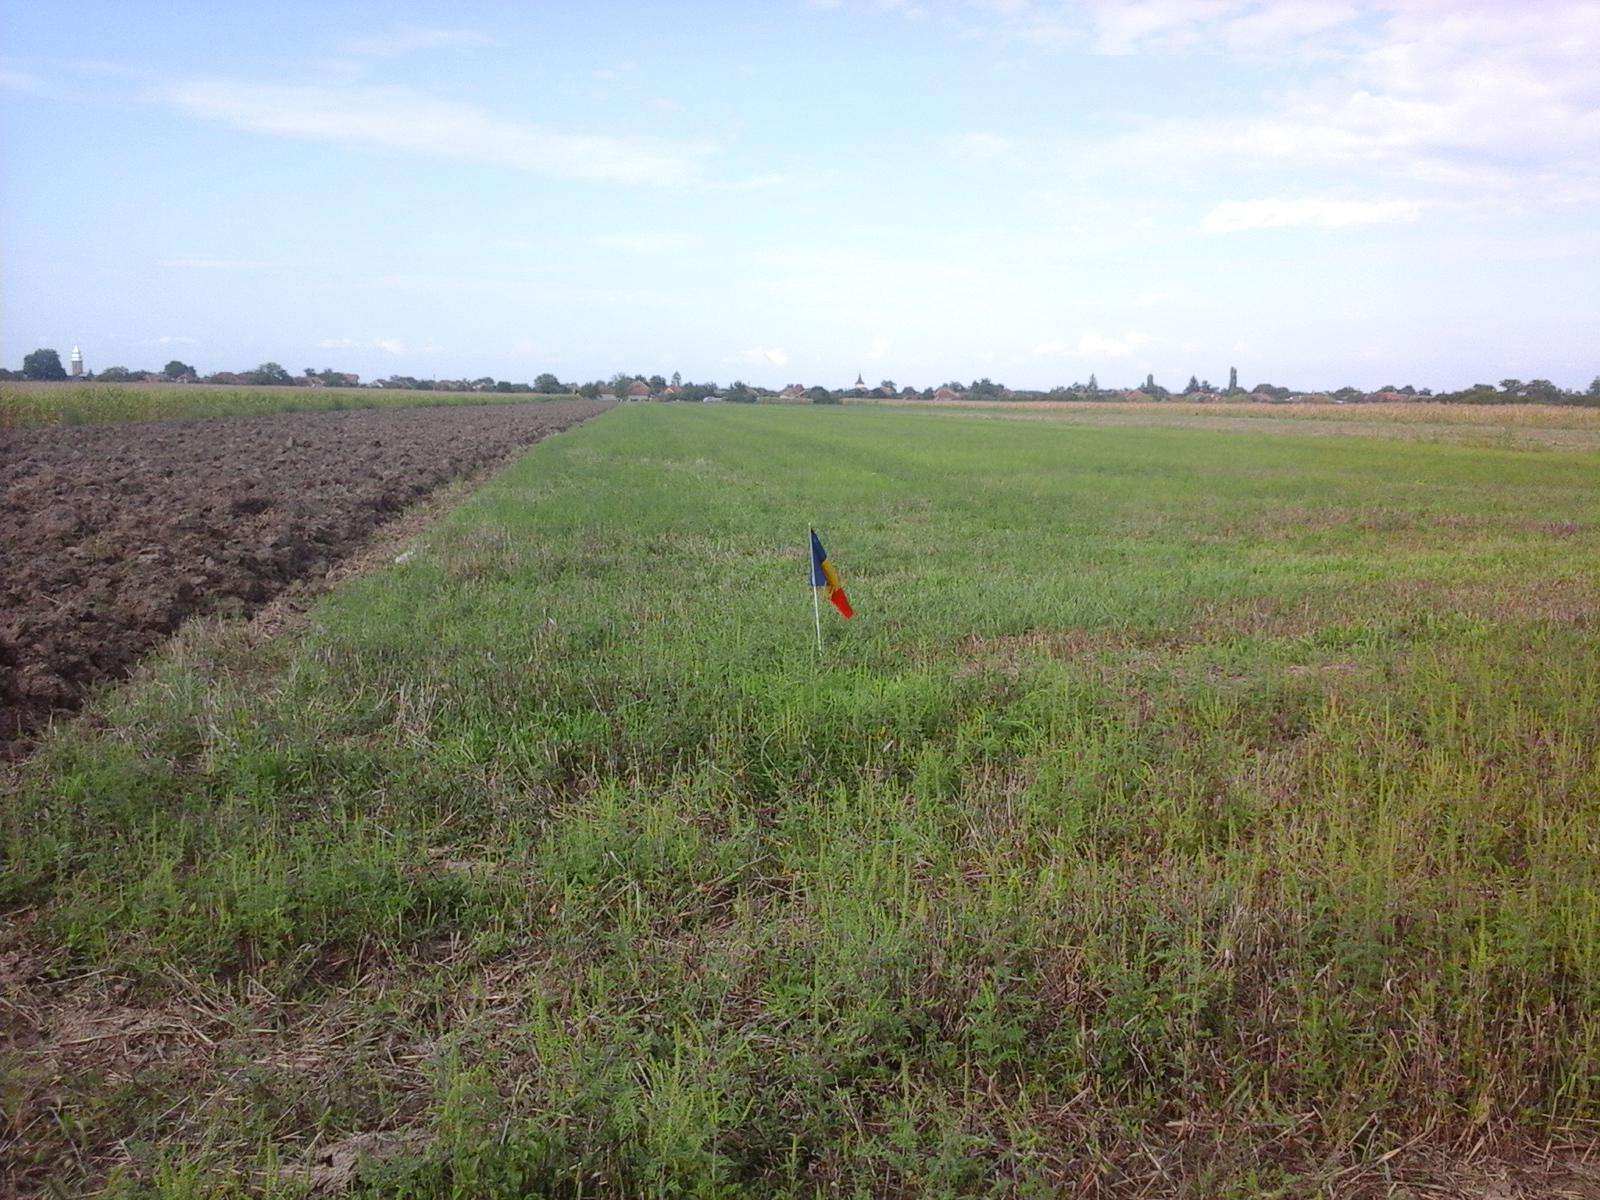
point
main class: Cropland
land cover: Common wheat
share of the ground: 25 - 50 %
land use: Agriculture (excluding fallow land and kitchen gardens)
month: August
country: RO
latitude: 46.7104
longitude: 21.6698
